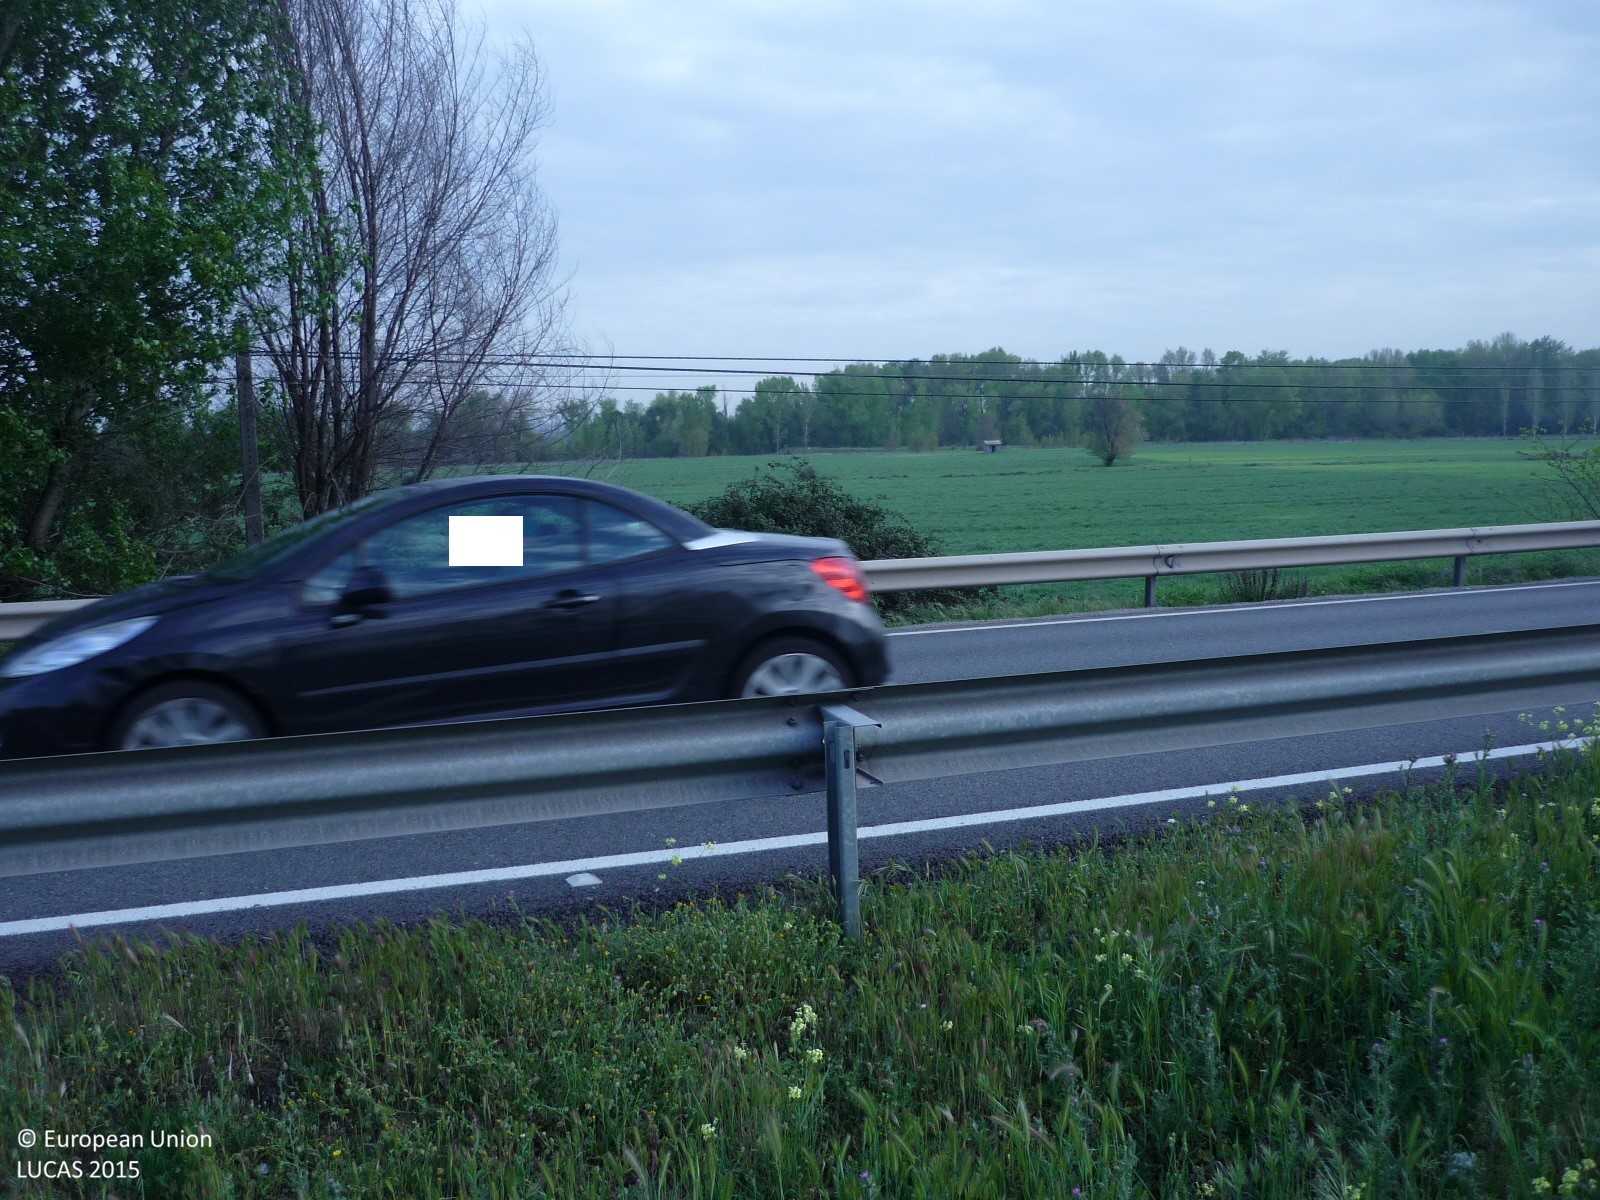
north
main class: Grassland
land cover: Grassland without tree/shrub cover
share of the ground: 25 - 50 %
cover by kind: consolidated bare surface 60 %, herbaceous plants 25 %, unconsolidated bare surface 15 %
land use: Semi-natural and natural areas not in use
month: April
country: ES
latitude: 40.5840
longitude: -3.5655
